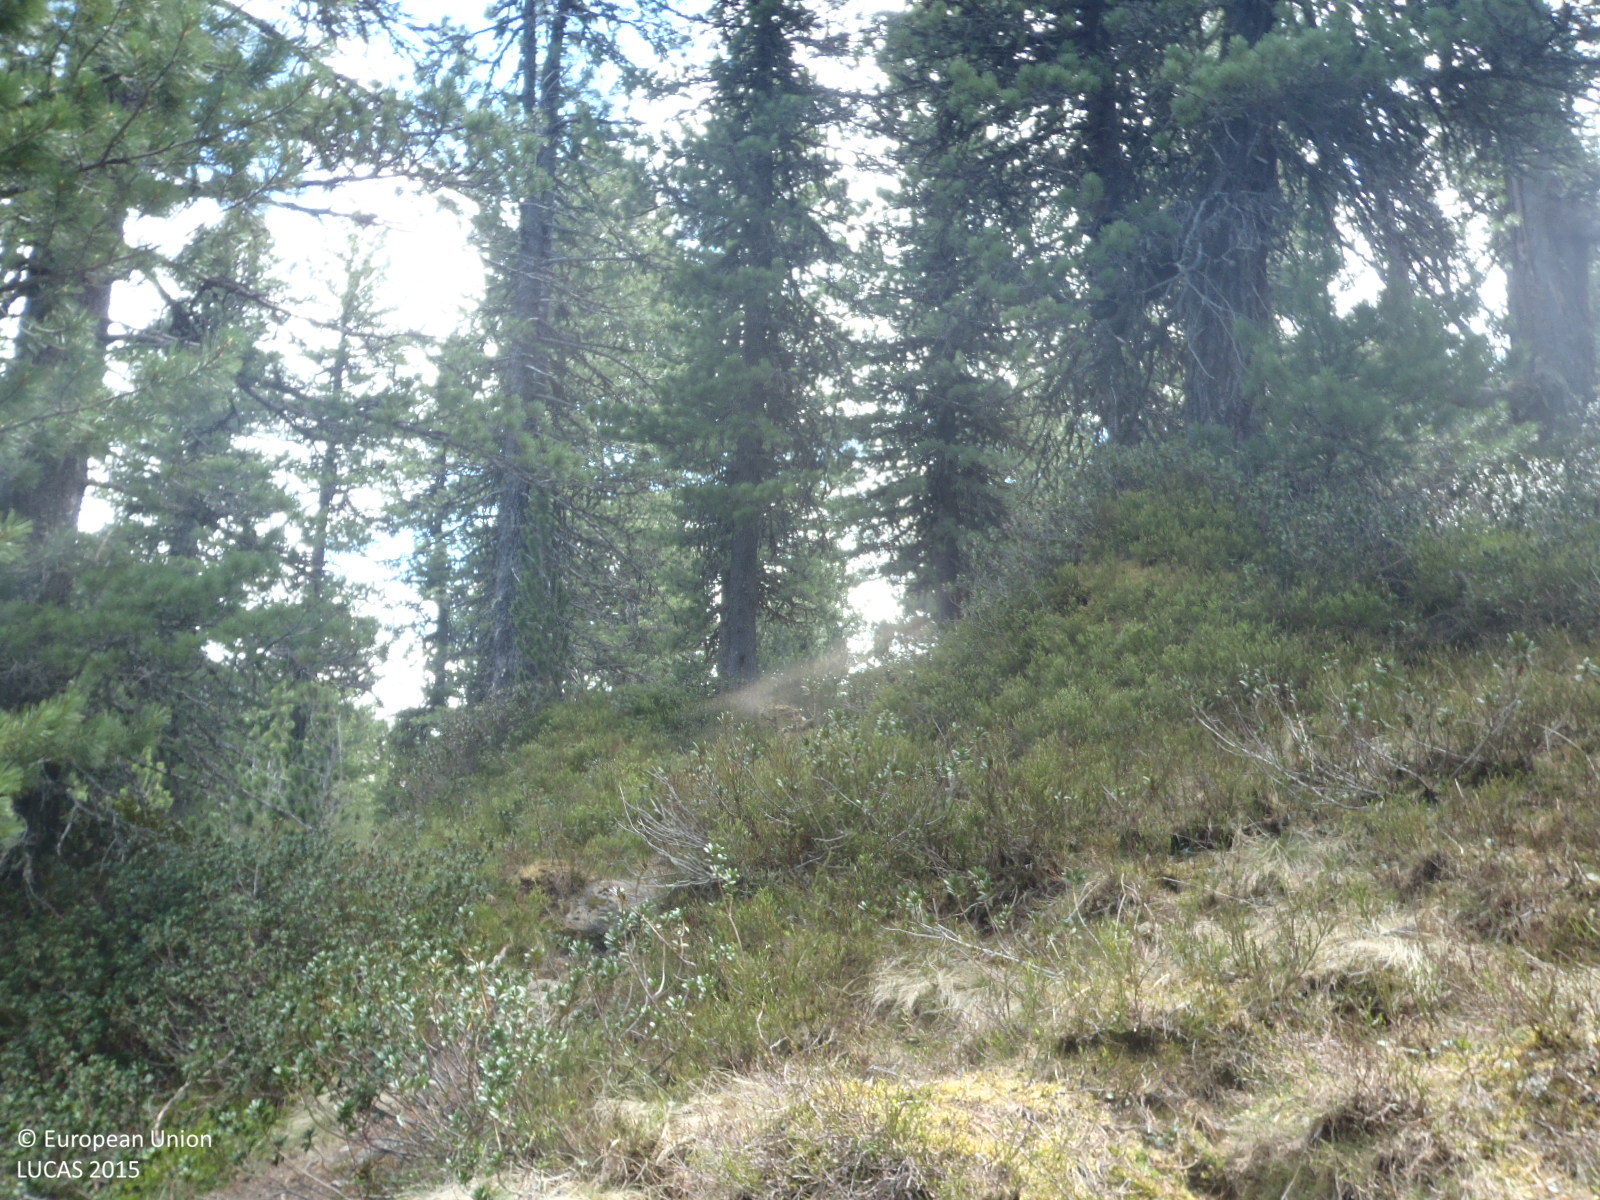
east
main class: Woodland
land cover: Other coniferous woodland
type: alpine coniferous forest
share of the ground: > 75 %
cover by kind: coniferous forest trees 75 %, shrubs 20 %, herbaceous plants 5 %
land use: Semi-natural and natural areas not in use
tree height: > 5 m
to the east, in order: Other coniferous woodland; Shrubland with sparse tree cover; Other coniferous woodland
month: June
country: AT
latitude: 47.2111
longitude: 10.9893
